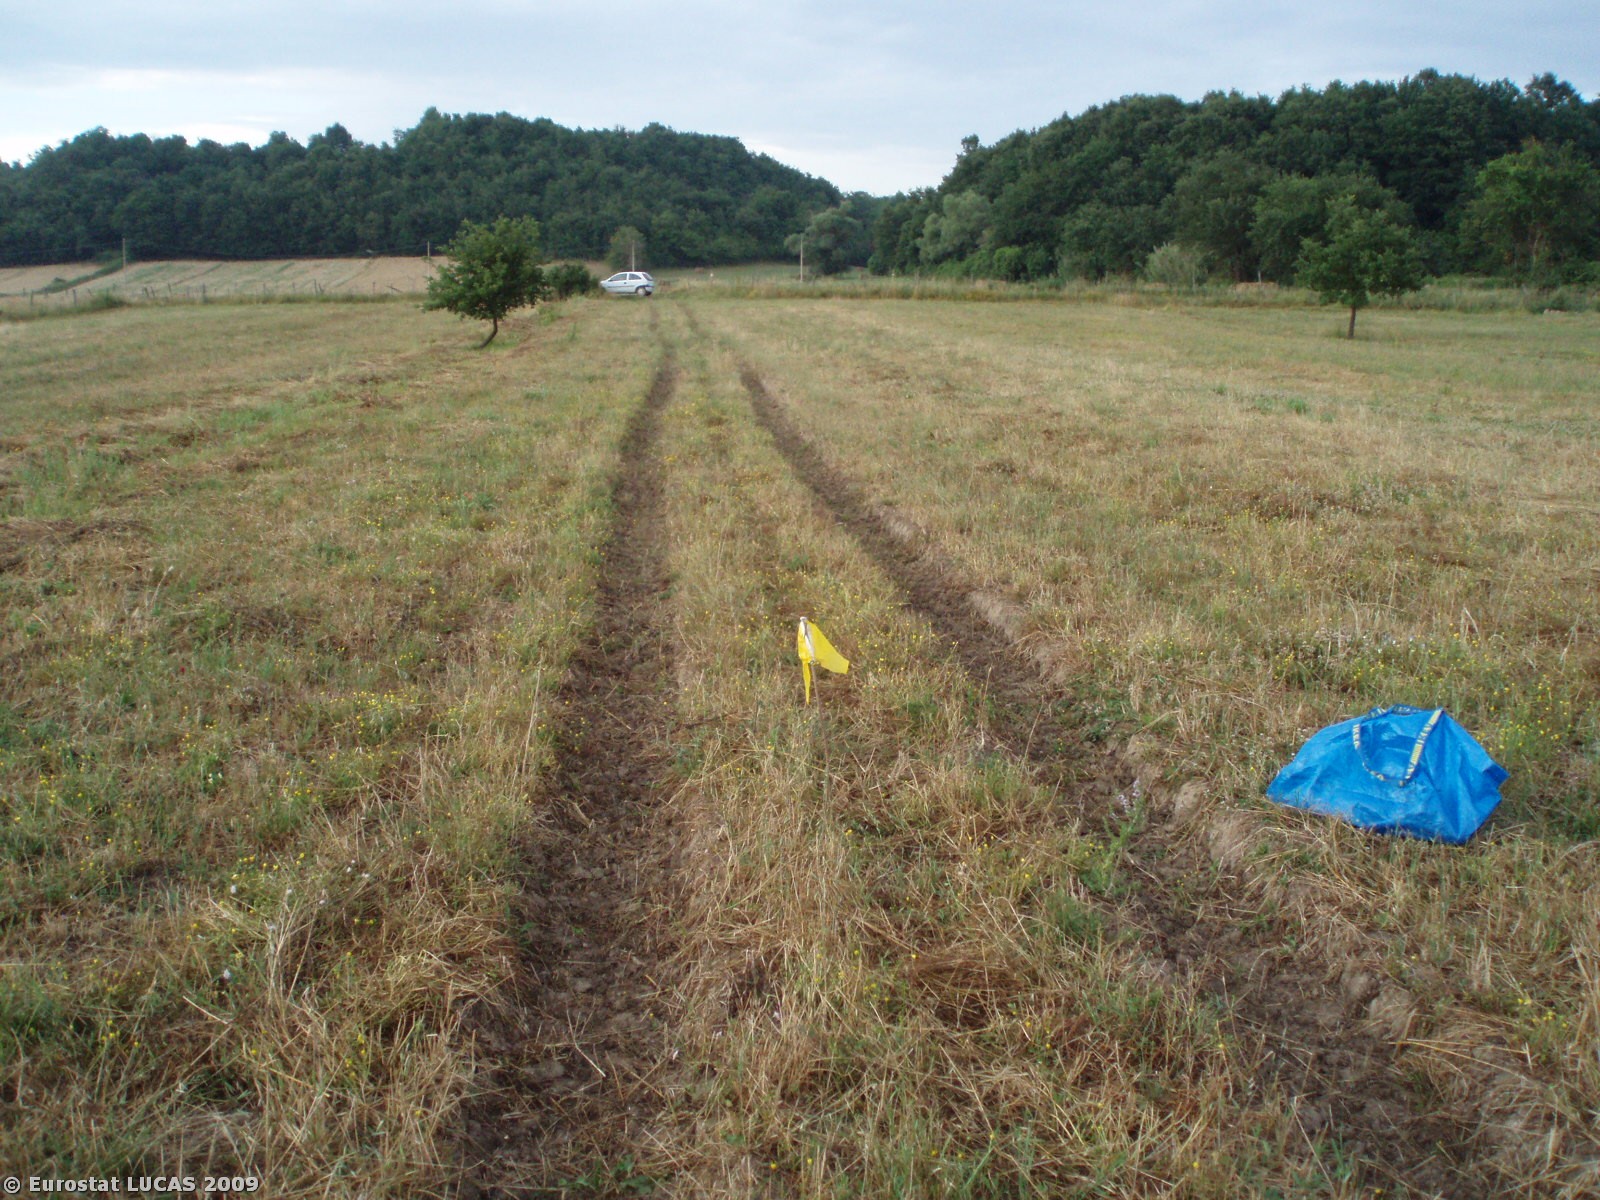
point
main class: Grassland
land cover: Grassland without tree/shrub cover
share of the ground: > 75 %
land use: Agriculture (excluding fallow land and kitchen gardens)
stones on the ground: < 10 %
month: June
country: IT
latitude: 42.6054
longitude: 11.5914
